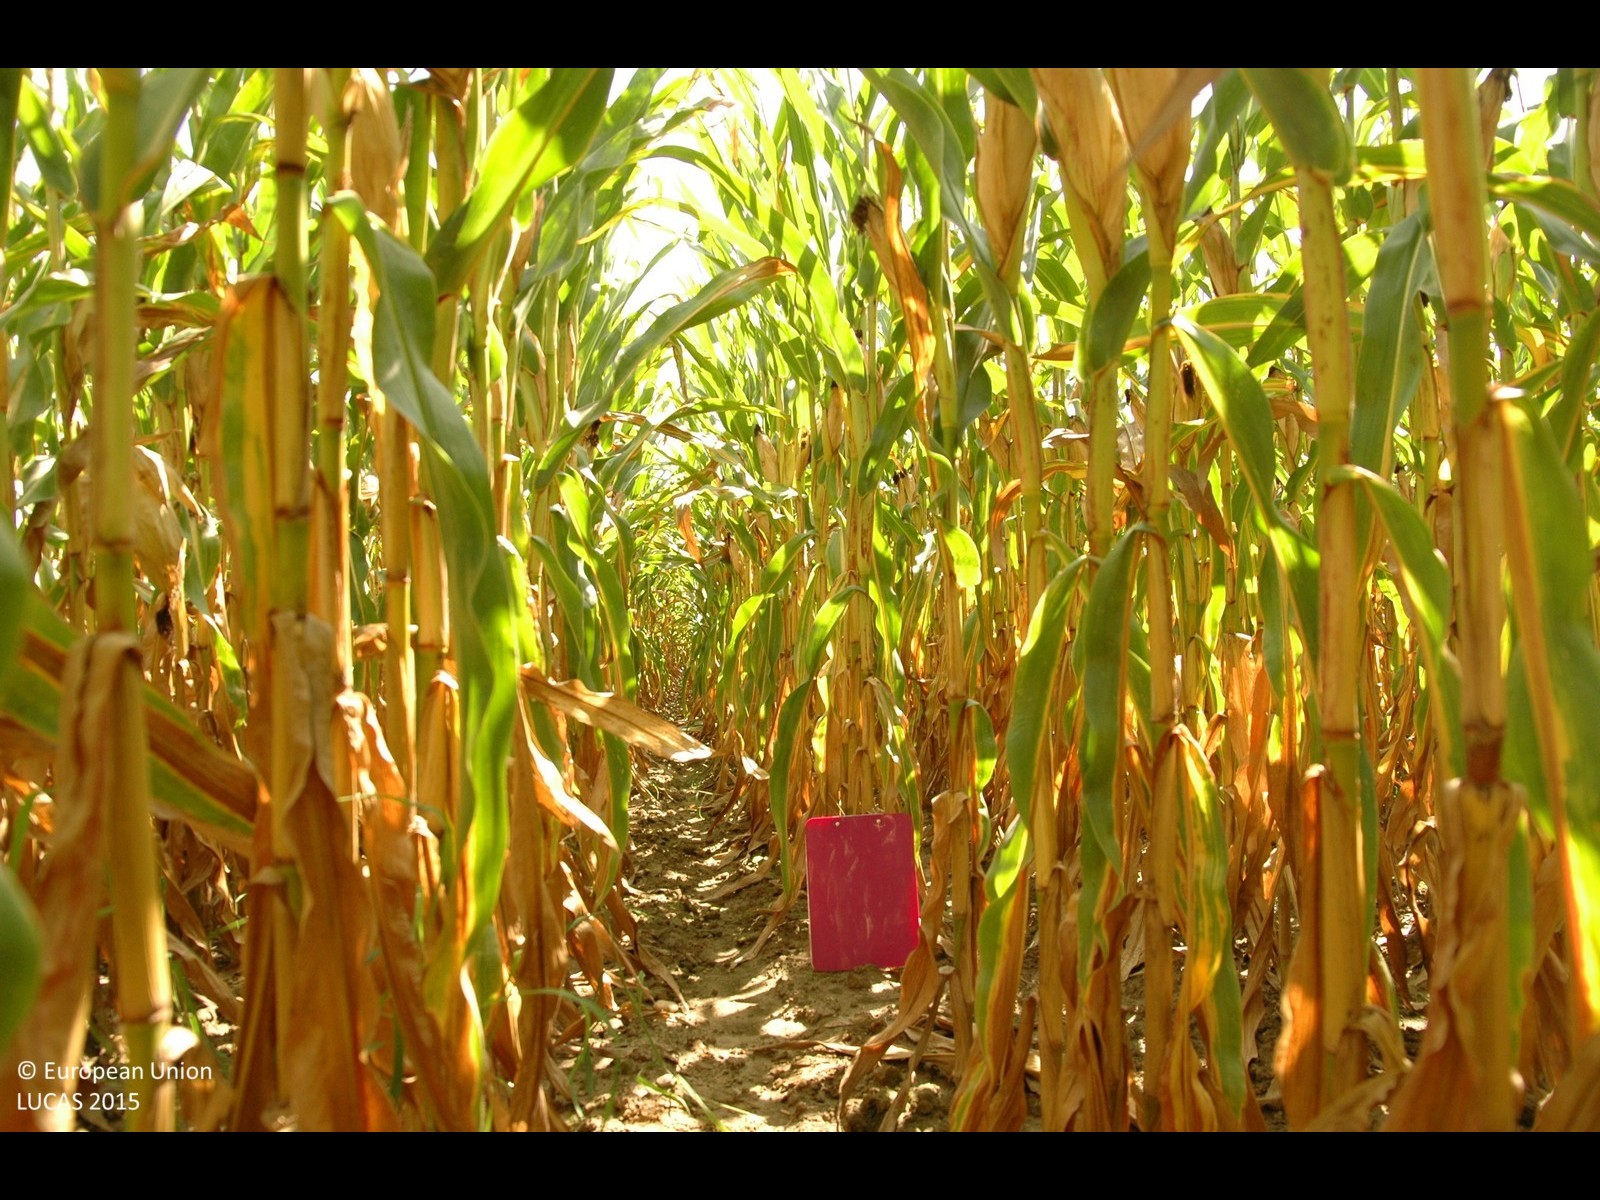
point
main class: Cropland
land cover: Maize
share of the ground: > 75 %
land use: Agriculture (excluding fallow land and kitchen gardens)
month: August
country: HR
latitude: 46.2734
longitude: 16.8923
